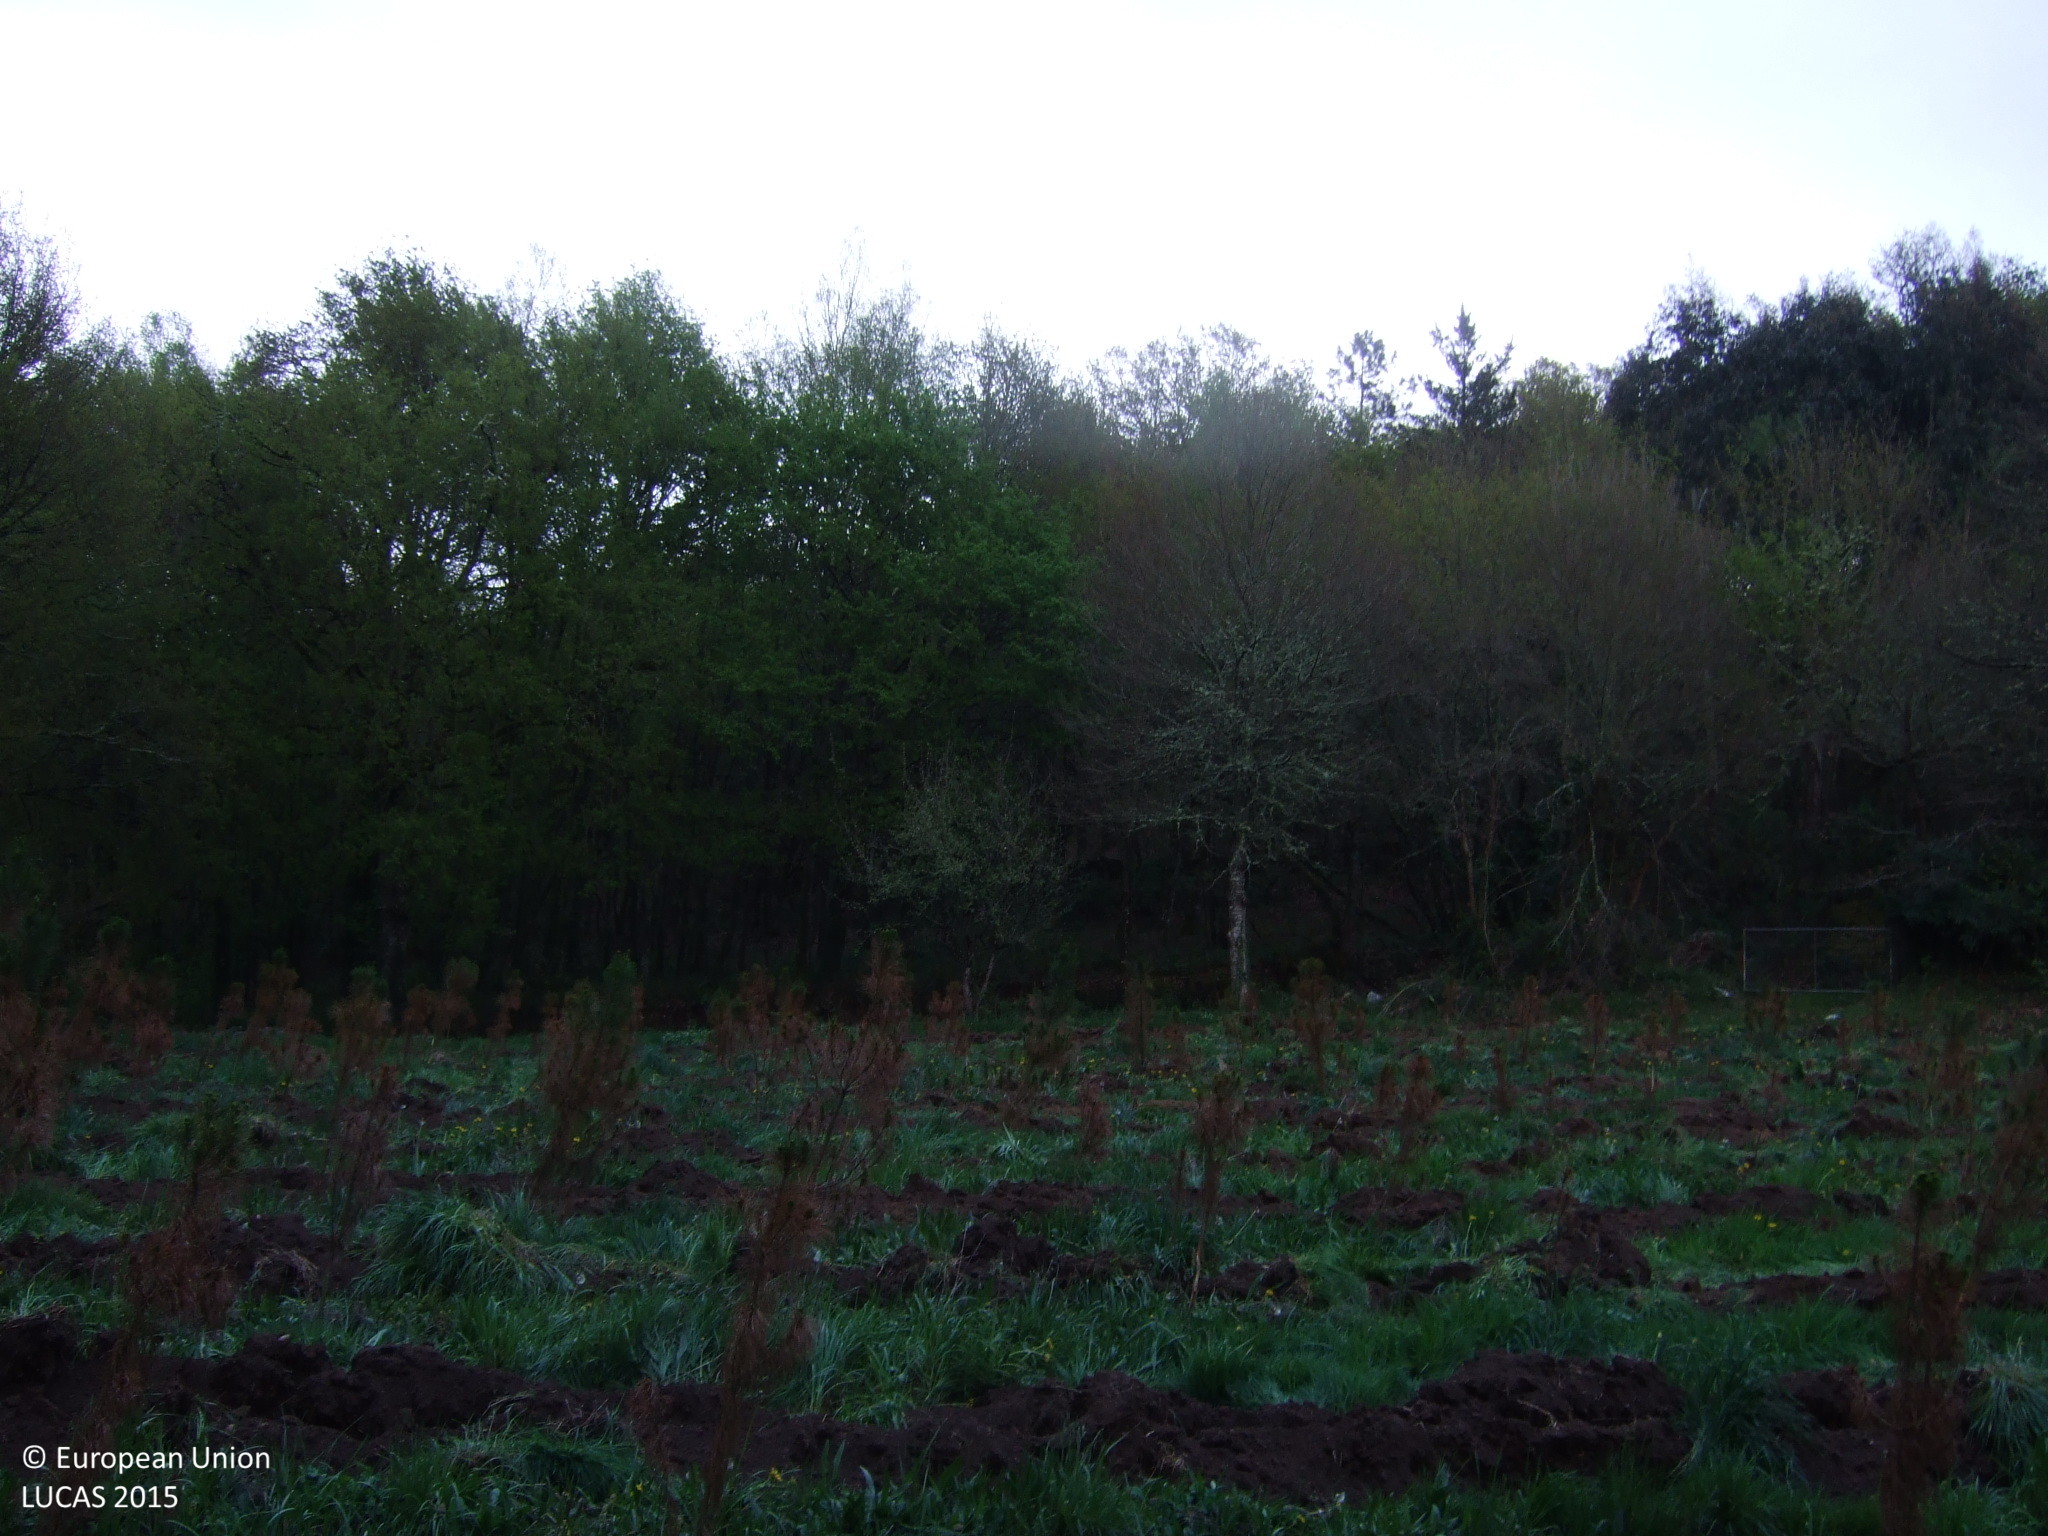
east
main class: Grassland
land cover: Grassland with sparse tree/shrub cover
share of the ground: > 75 %
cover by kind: herbaceous plants 80 %, unconsolidated bare surface 15 %, coniferous forest trees 5 %
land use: Forestry
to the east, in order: Grassland with sparse tree/shrub cover; Groves; Paved roads, cycling and walking lanes; Broadleaved woodland; Tracks; Dry stone walls; Broadleaved woodland; Dry stone walls; Broadleaved woodland; Dry stone walls; Broadleaved woodland
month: April
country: ES
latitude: 42.9722
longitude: -7.3218
